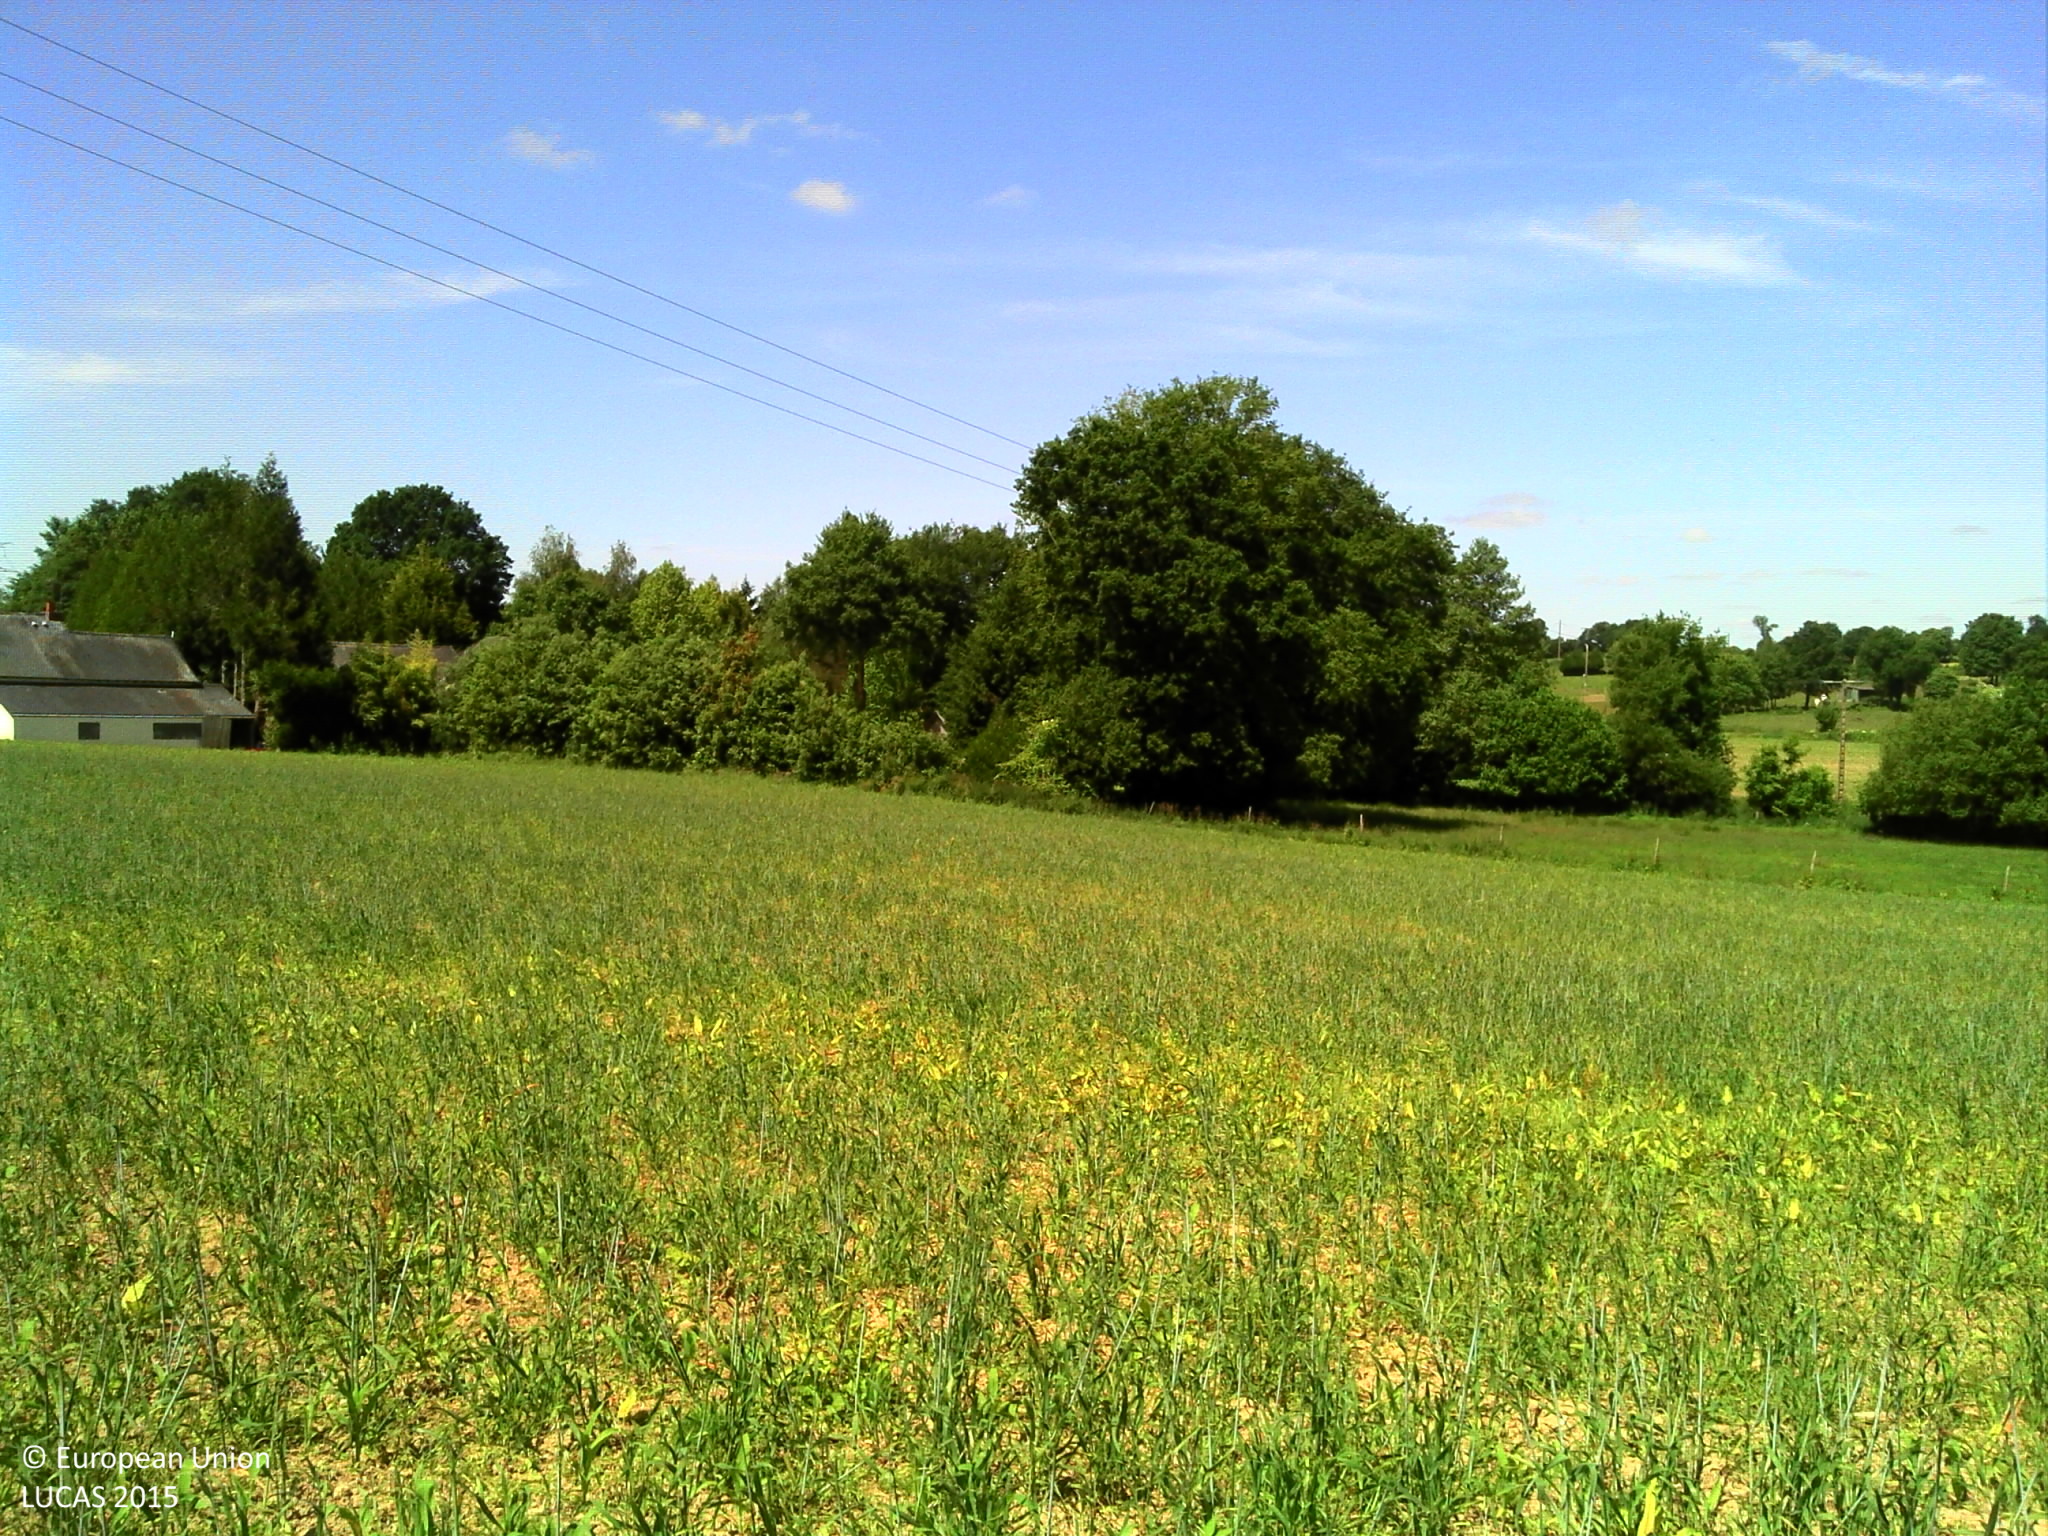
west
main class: Cropland
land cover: Maize
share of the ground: > 75 %
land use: Agriculture (excluding fallow land and kitchen gardens)
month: June
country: FR
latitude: 48.0950
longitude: -1.4717
